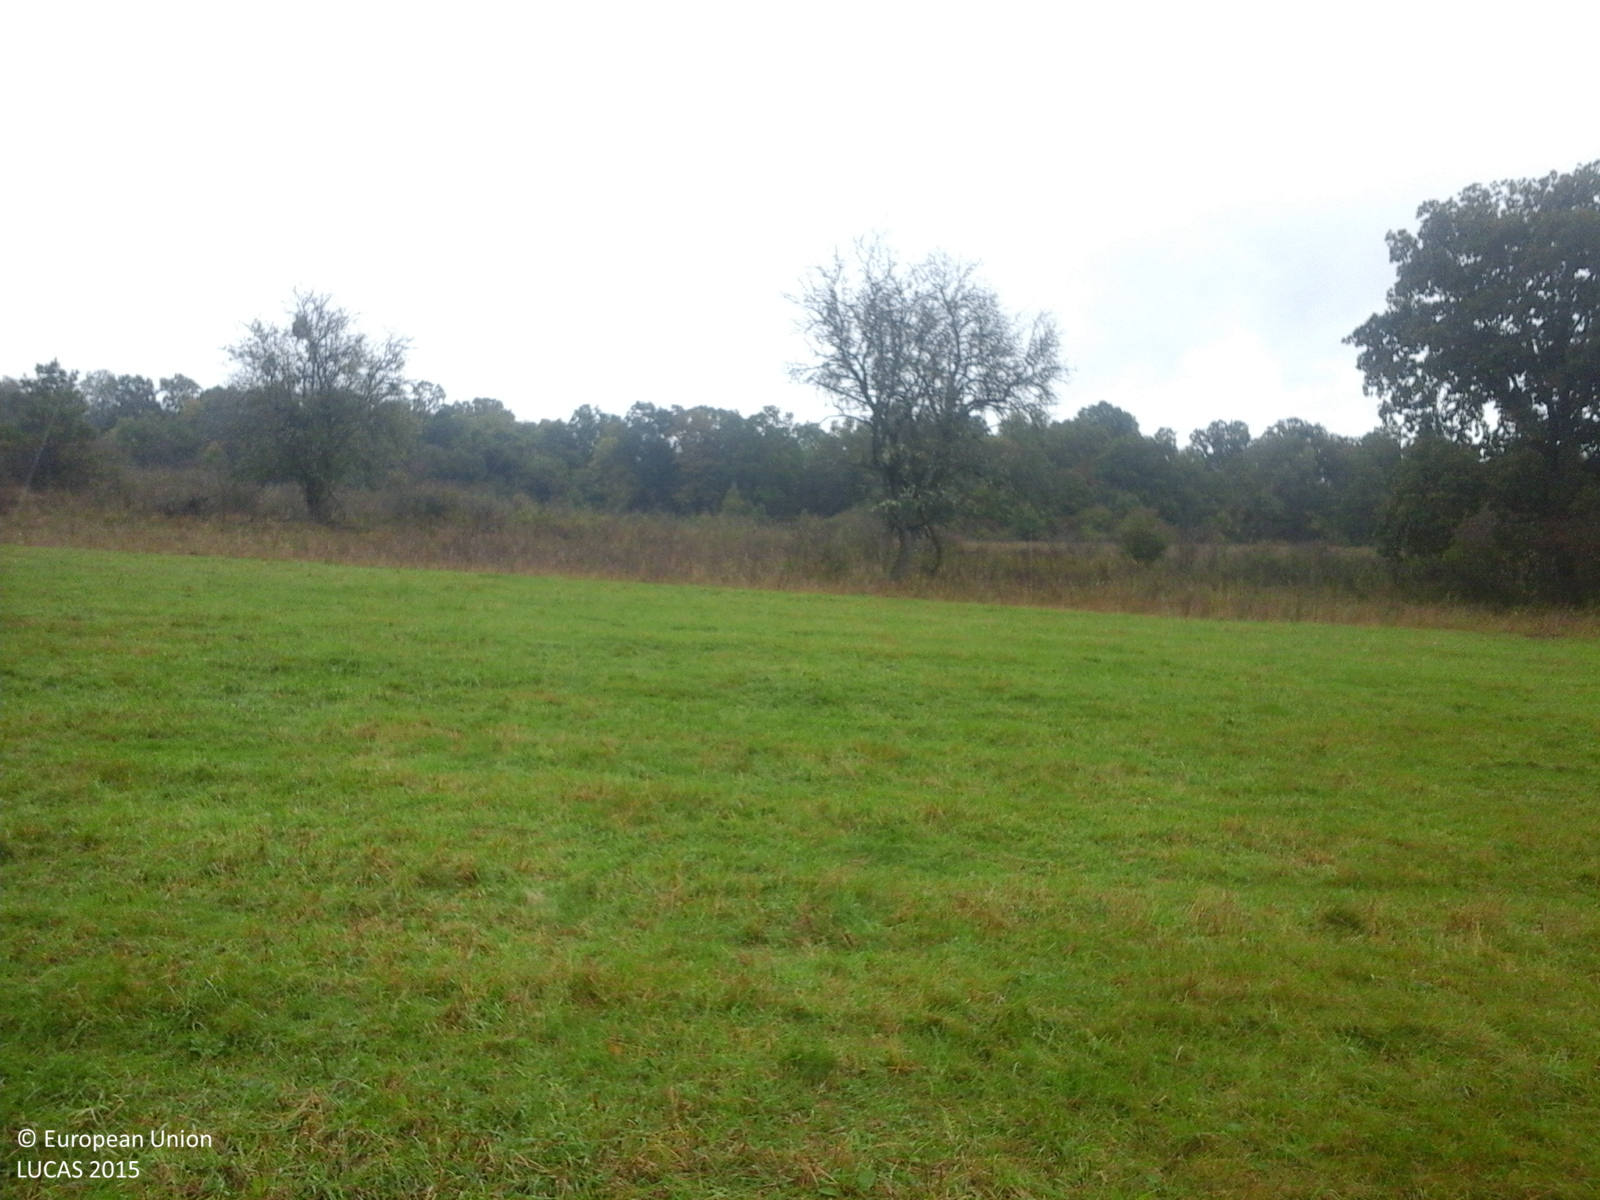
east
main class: Grassland
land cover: Grassland without tree/shrub cover
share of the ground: > 75 %
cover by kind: herbaceous plants 100 %
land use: Agriculture (excluding fallow land and kitchen gardens)
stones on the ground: < 10 %
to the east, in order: Grassland without tree/shrub cover; Grassland with sparse tree/shrub cover; Grassland without tree/shrub cover
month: October
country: RO
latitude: 45.8305
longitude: 24.6445
